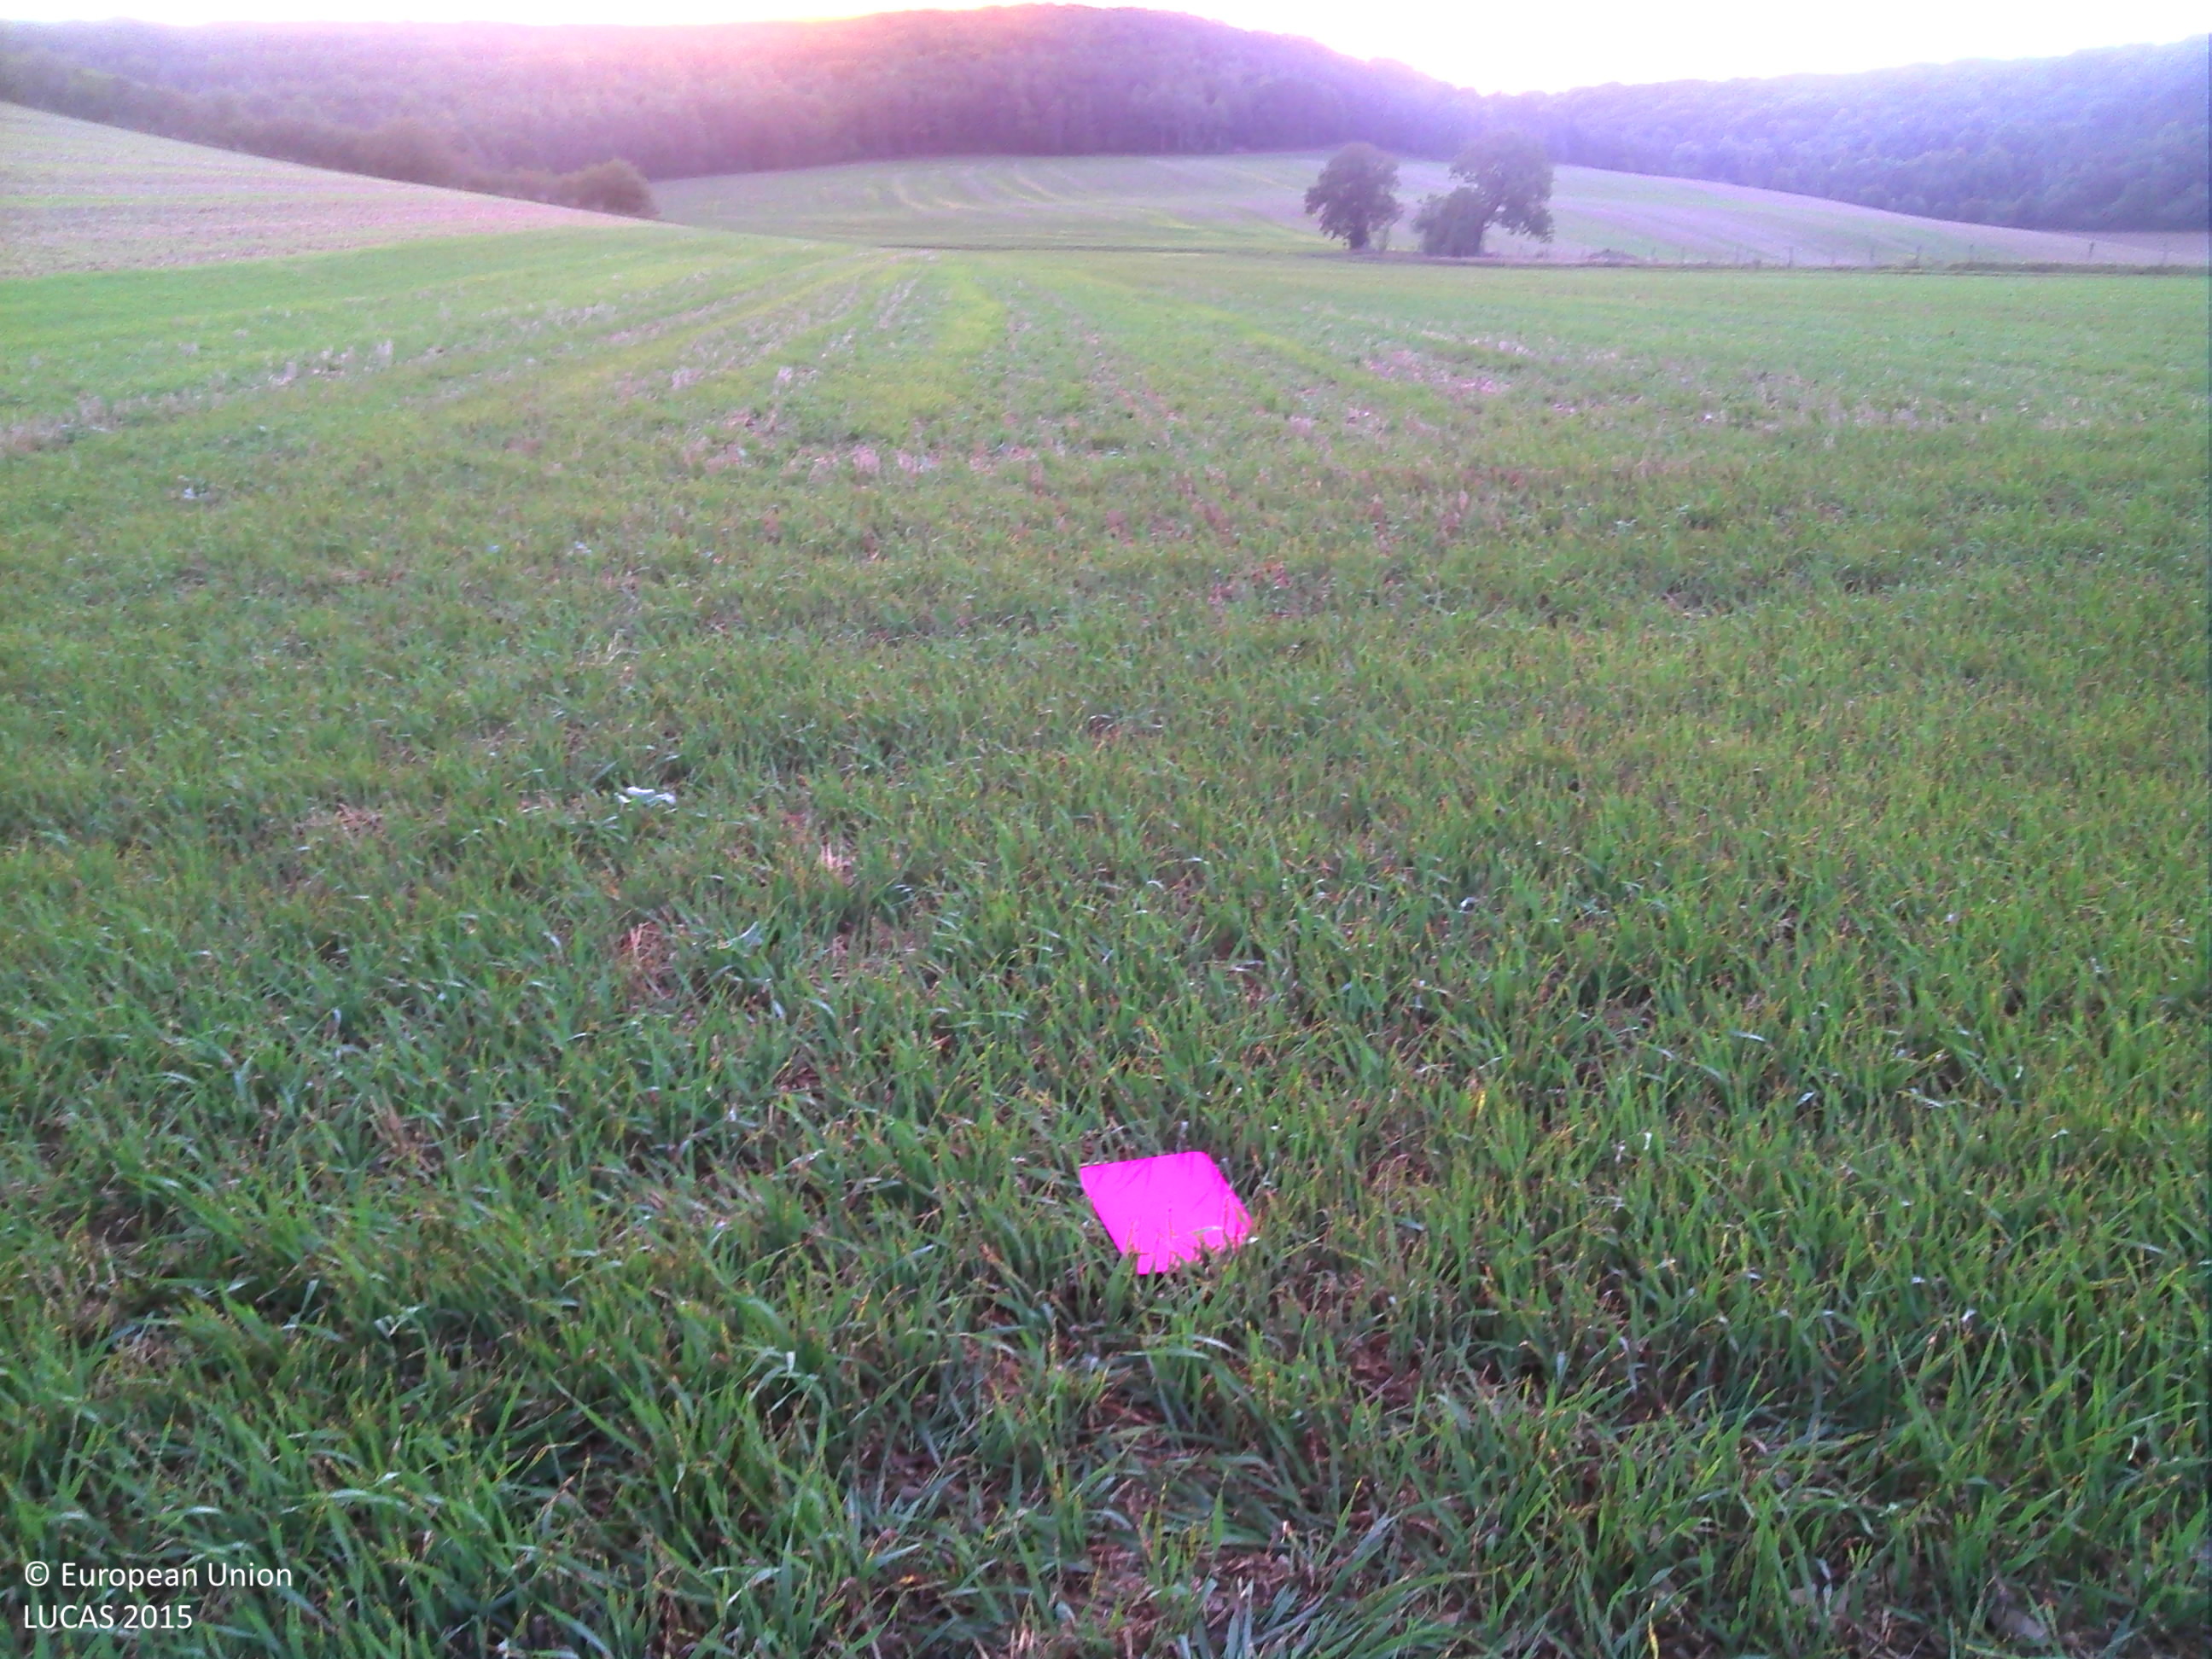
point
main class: Cropland
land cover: Barley
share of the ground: > 75 %
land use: Agriculture (excluding fallow land and kitchen gardens)
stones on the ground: 25 - 50 %
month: September
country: FR
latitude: 48.1189
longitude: 4.7998
